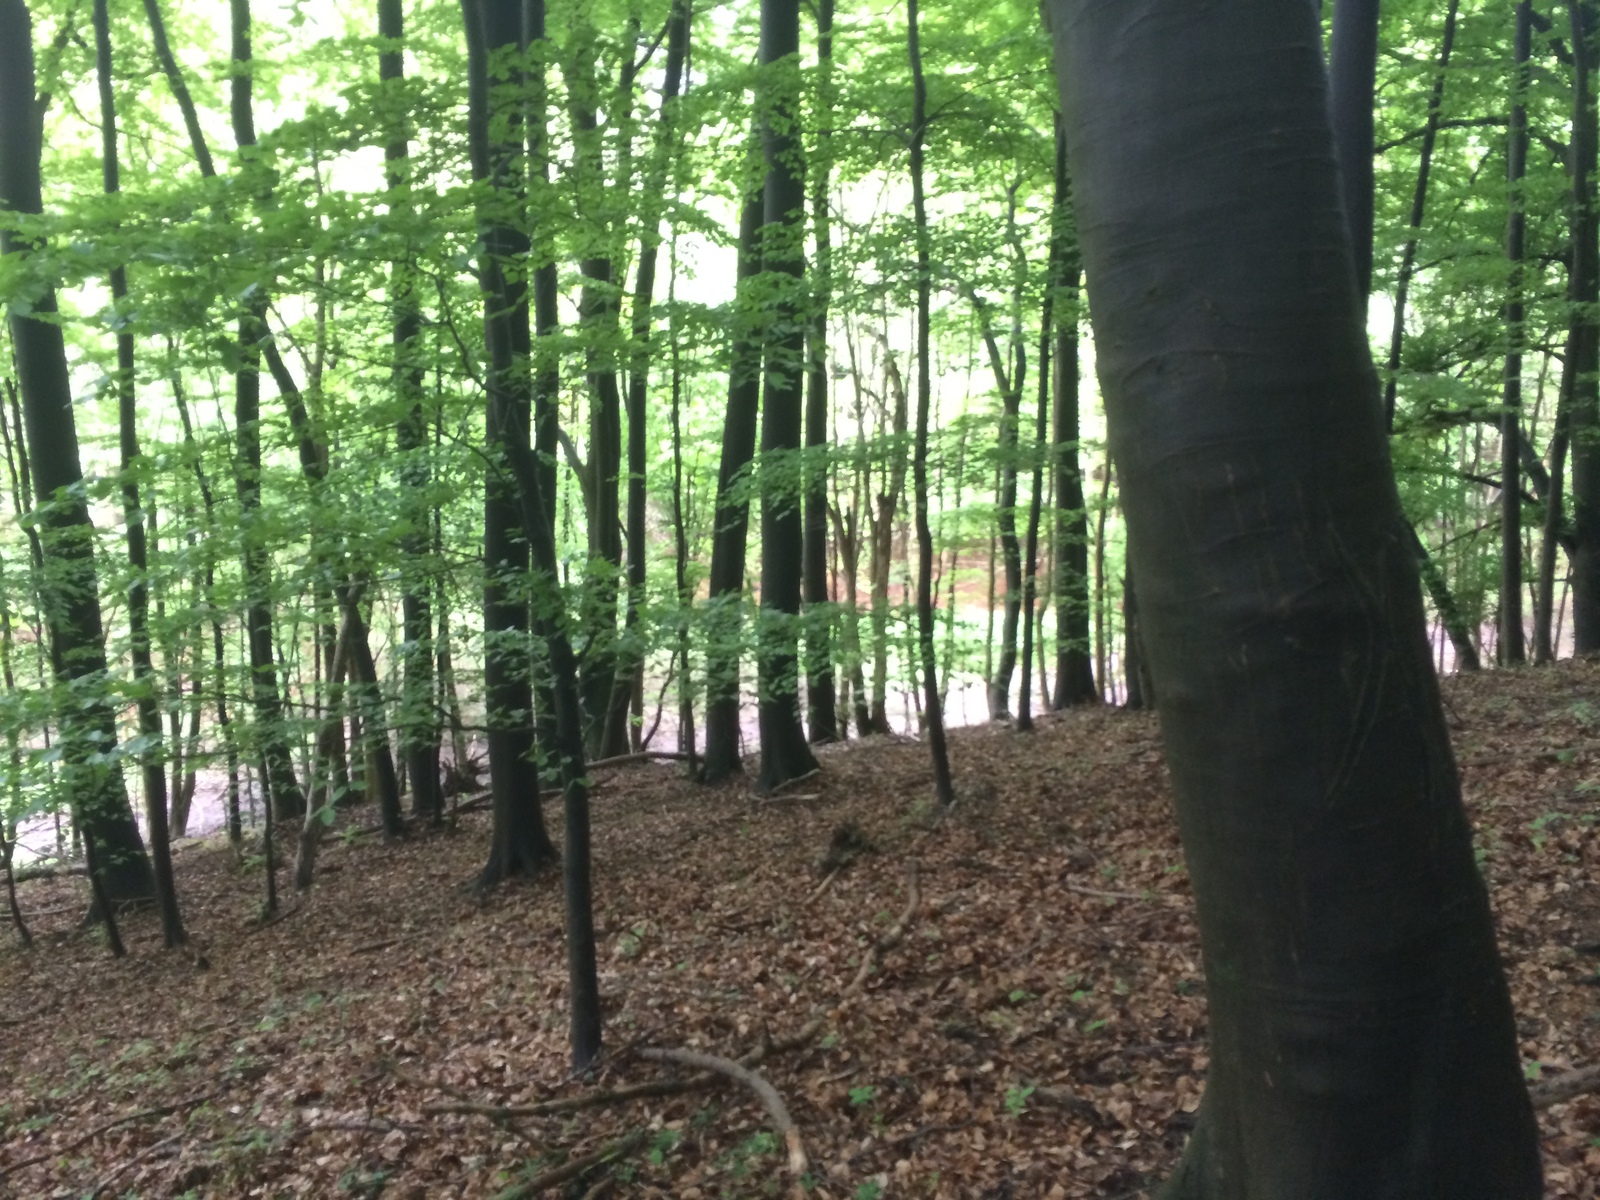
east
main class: Woodland
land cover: Broadleaved woodland
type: beech forest
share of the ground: > 75 %
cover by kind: broadleaved forest trees 100 %
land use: Forestry
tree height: > 5 m
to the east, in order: Broadleaved woodland; Fences; Broadleaved woodland; Rivers and streams; Broadleaved woodland; Fences; Broadleaved woodland
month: May
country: AT
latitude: 48.1050
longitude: 16.1684
